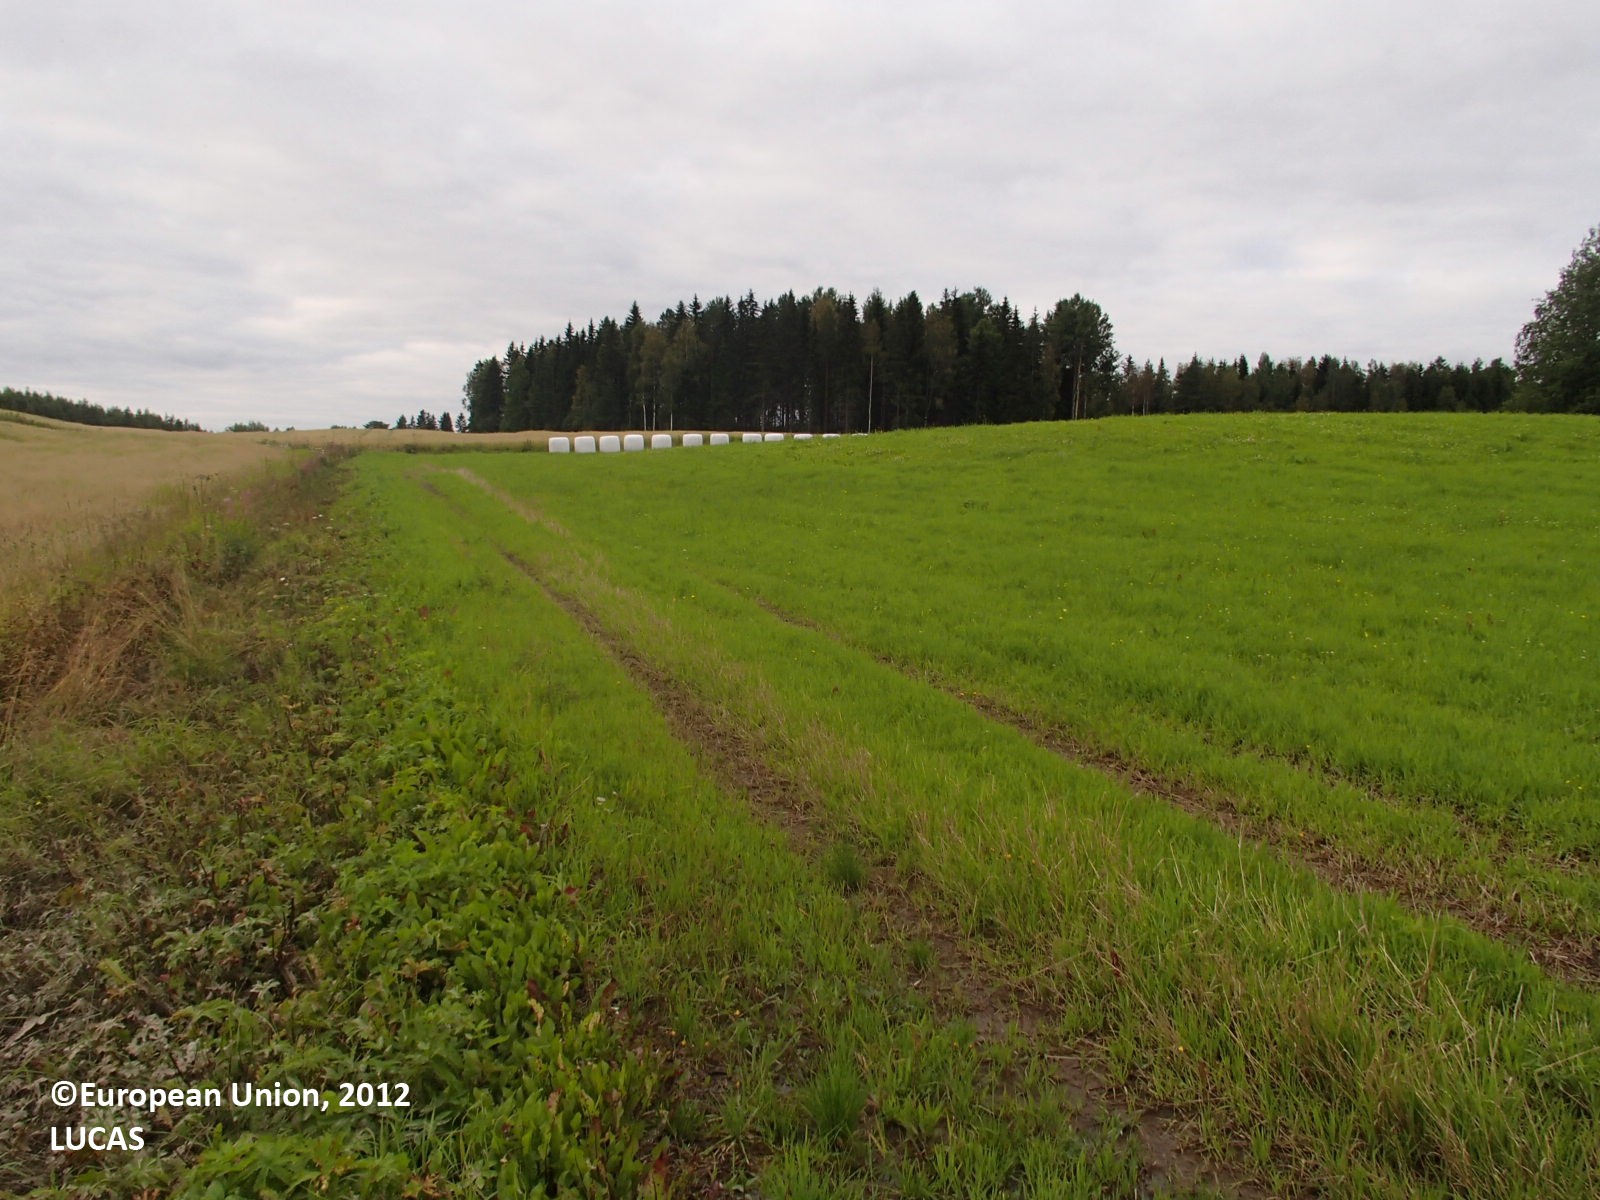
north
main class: Cropland
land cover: Oats
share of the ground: > 75 %
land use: Agriculture (excluding fallow land and kitchen gardens)
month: August
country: FI
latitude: 63.7379
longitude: 27.2623
